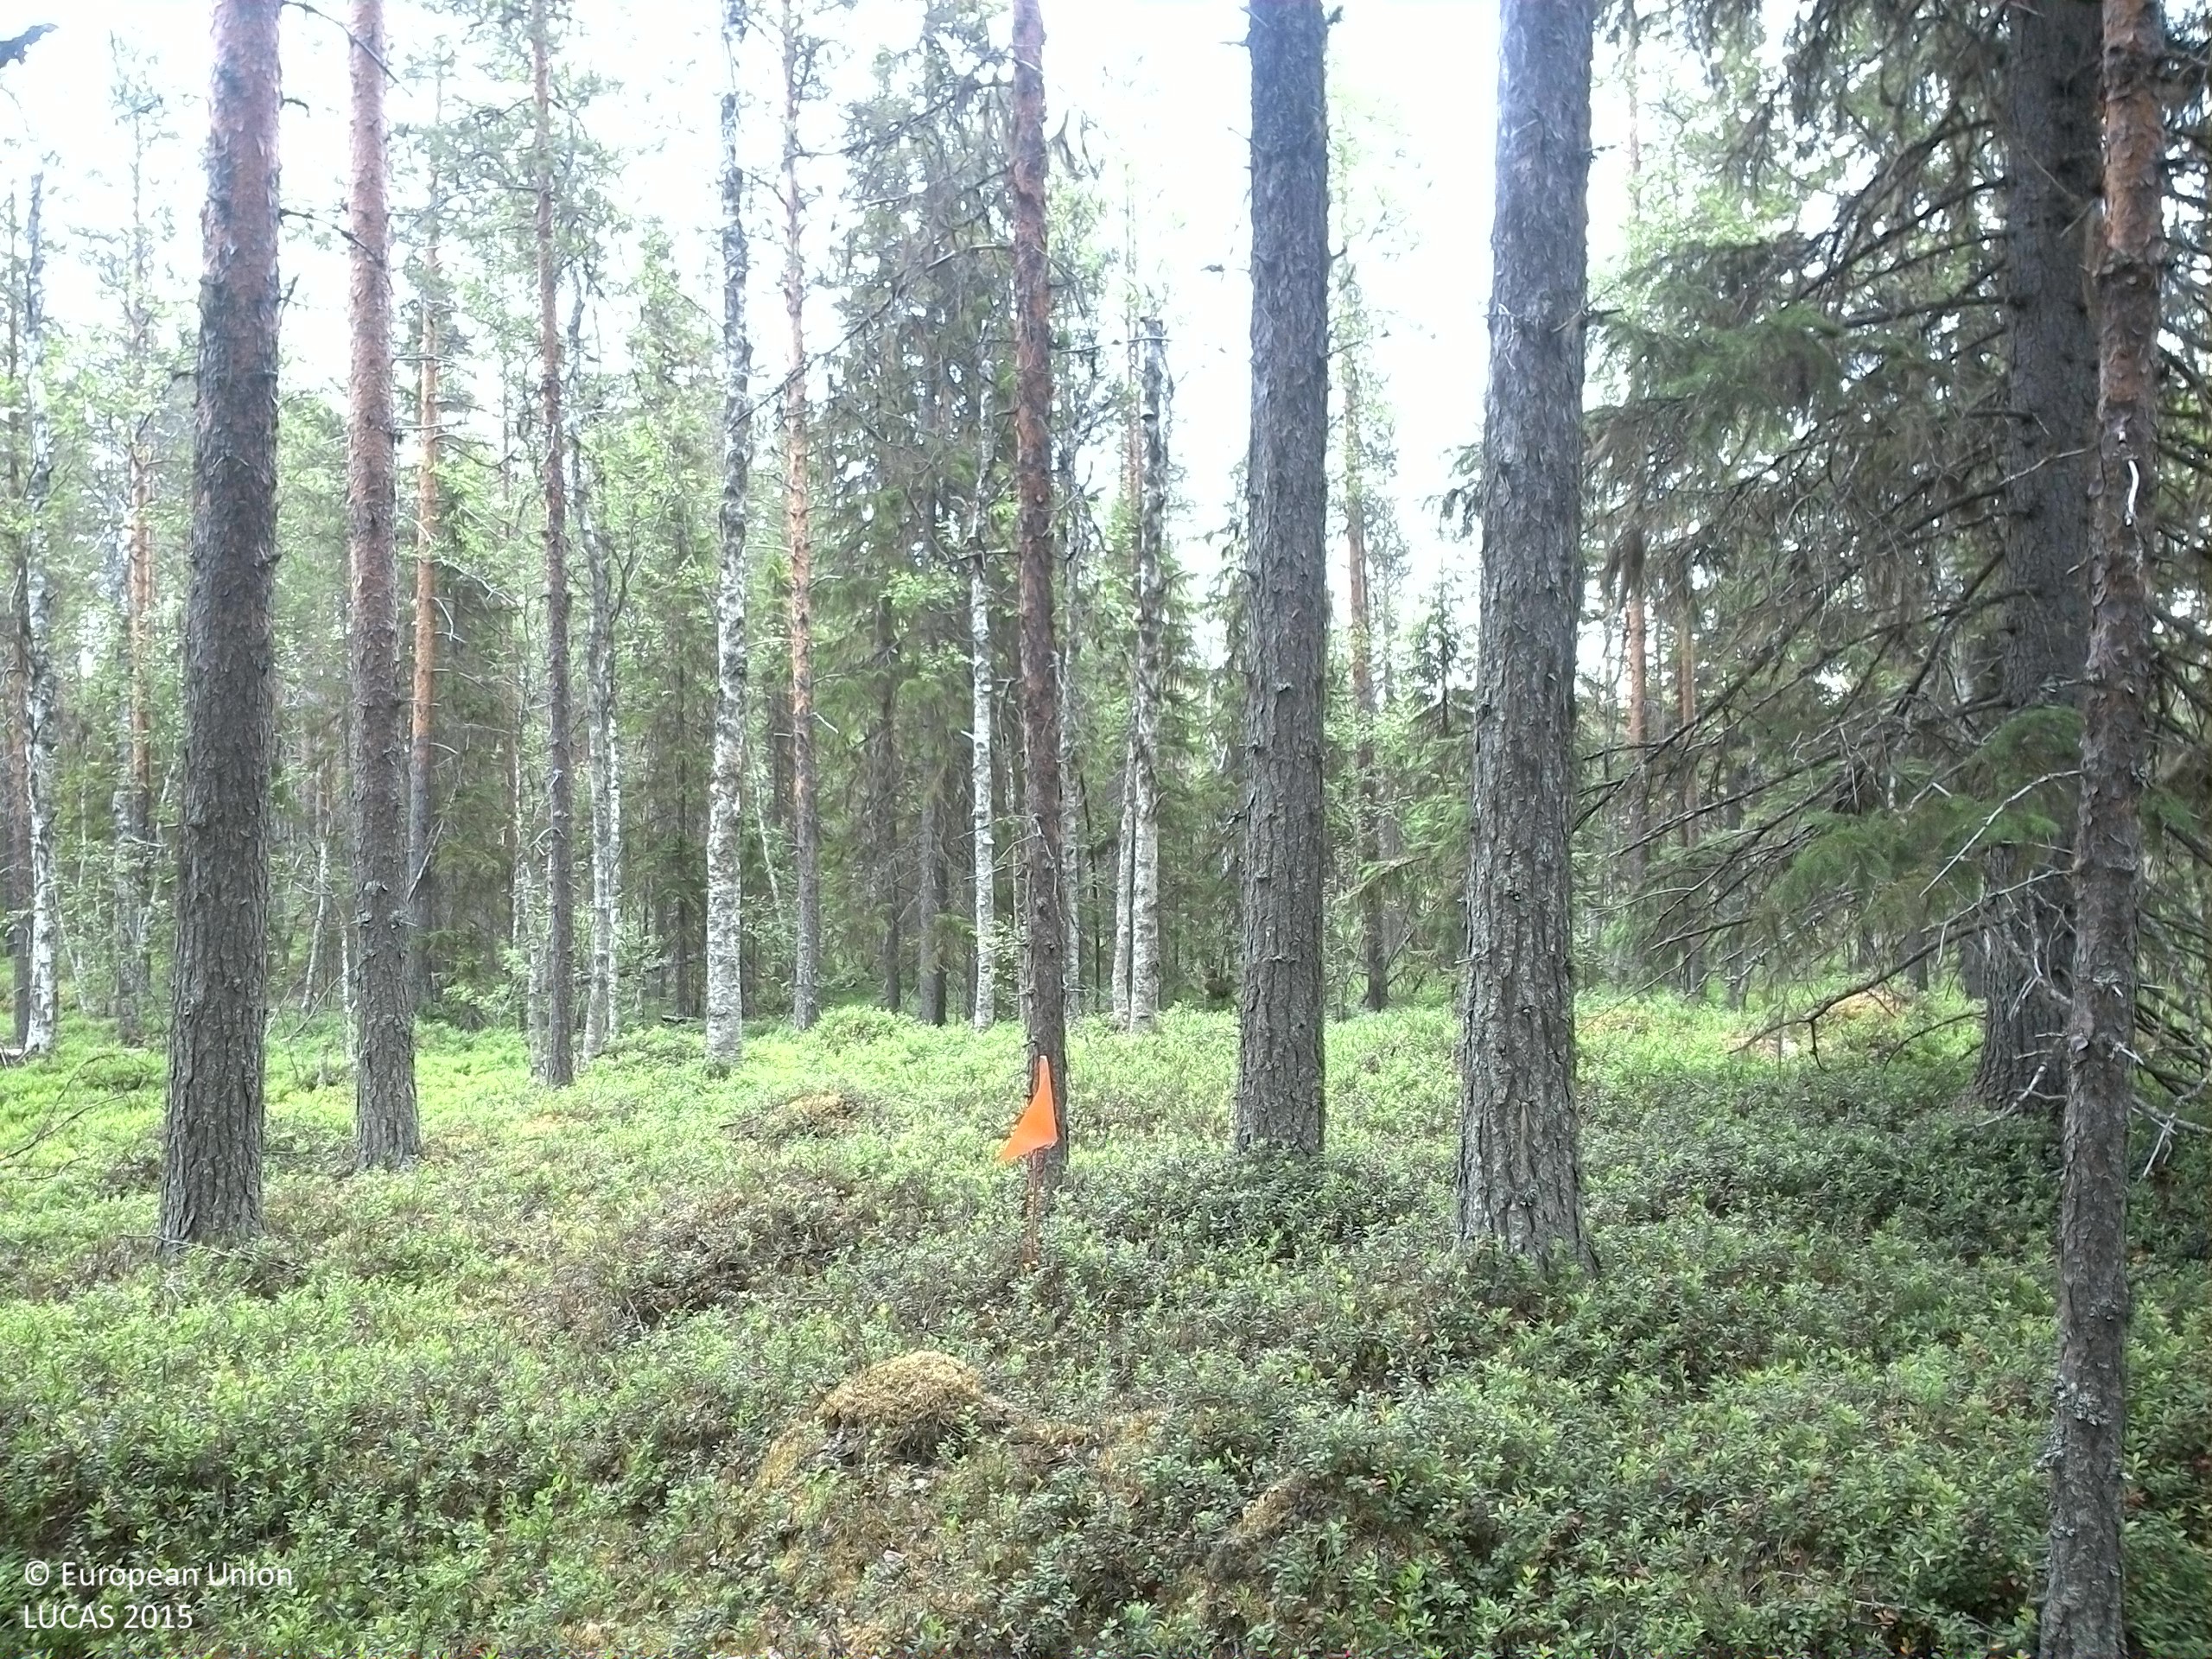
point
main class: Woodland
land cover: Pine dominated mixed woodland
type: boreal forest
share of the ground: 50 - 75 %
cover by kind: coniferous forest trees 40 %, shrubs 30 %, broadleaved forest trees 15 %, lichens and mosses 15 %
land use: Forestry
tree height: > 5 m
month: July
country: SE
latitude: 63.6400
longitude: 17.5027
